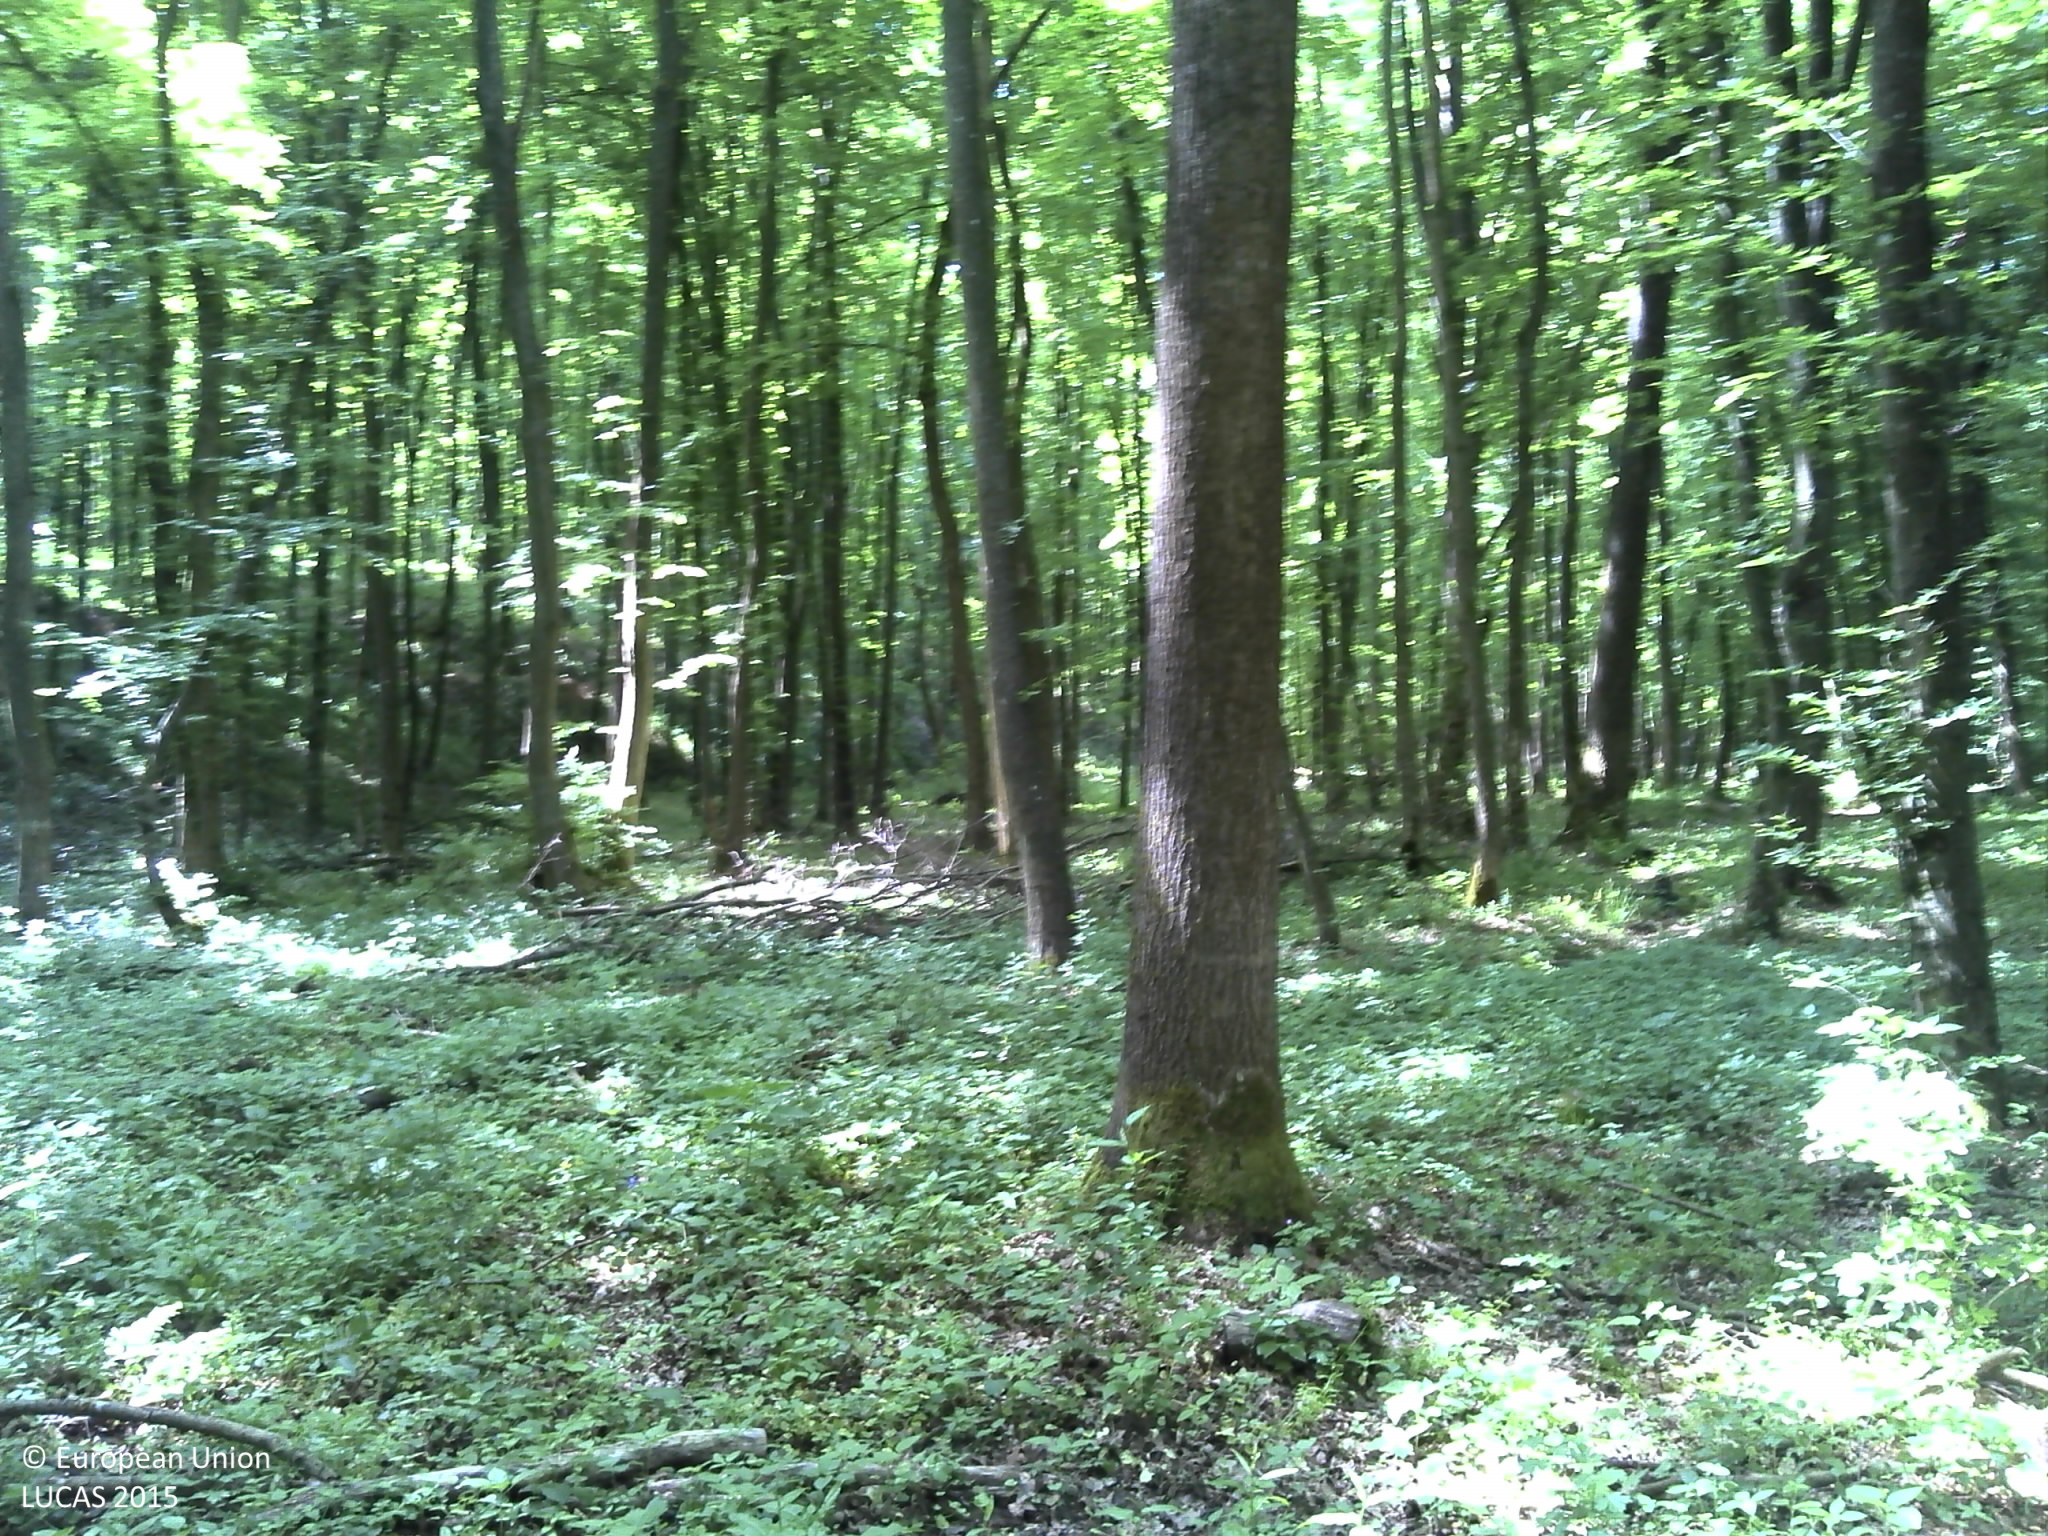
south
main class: Woodland
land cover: Broadleaved woodland
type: acidophilous oak and oak-birch forest
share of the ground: > 75 %
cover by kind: broadleaved forest trees 100 %
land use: Forestry
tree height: > 5 m
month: May
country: HR
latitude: 45.4207
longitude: 18.1962
